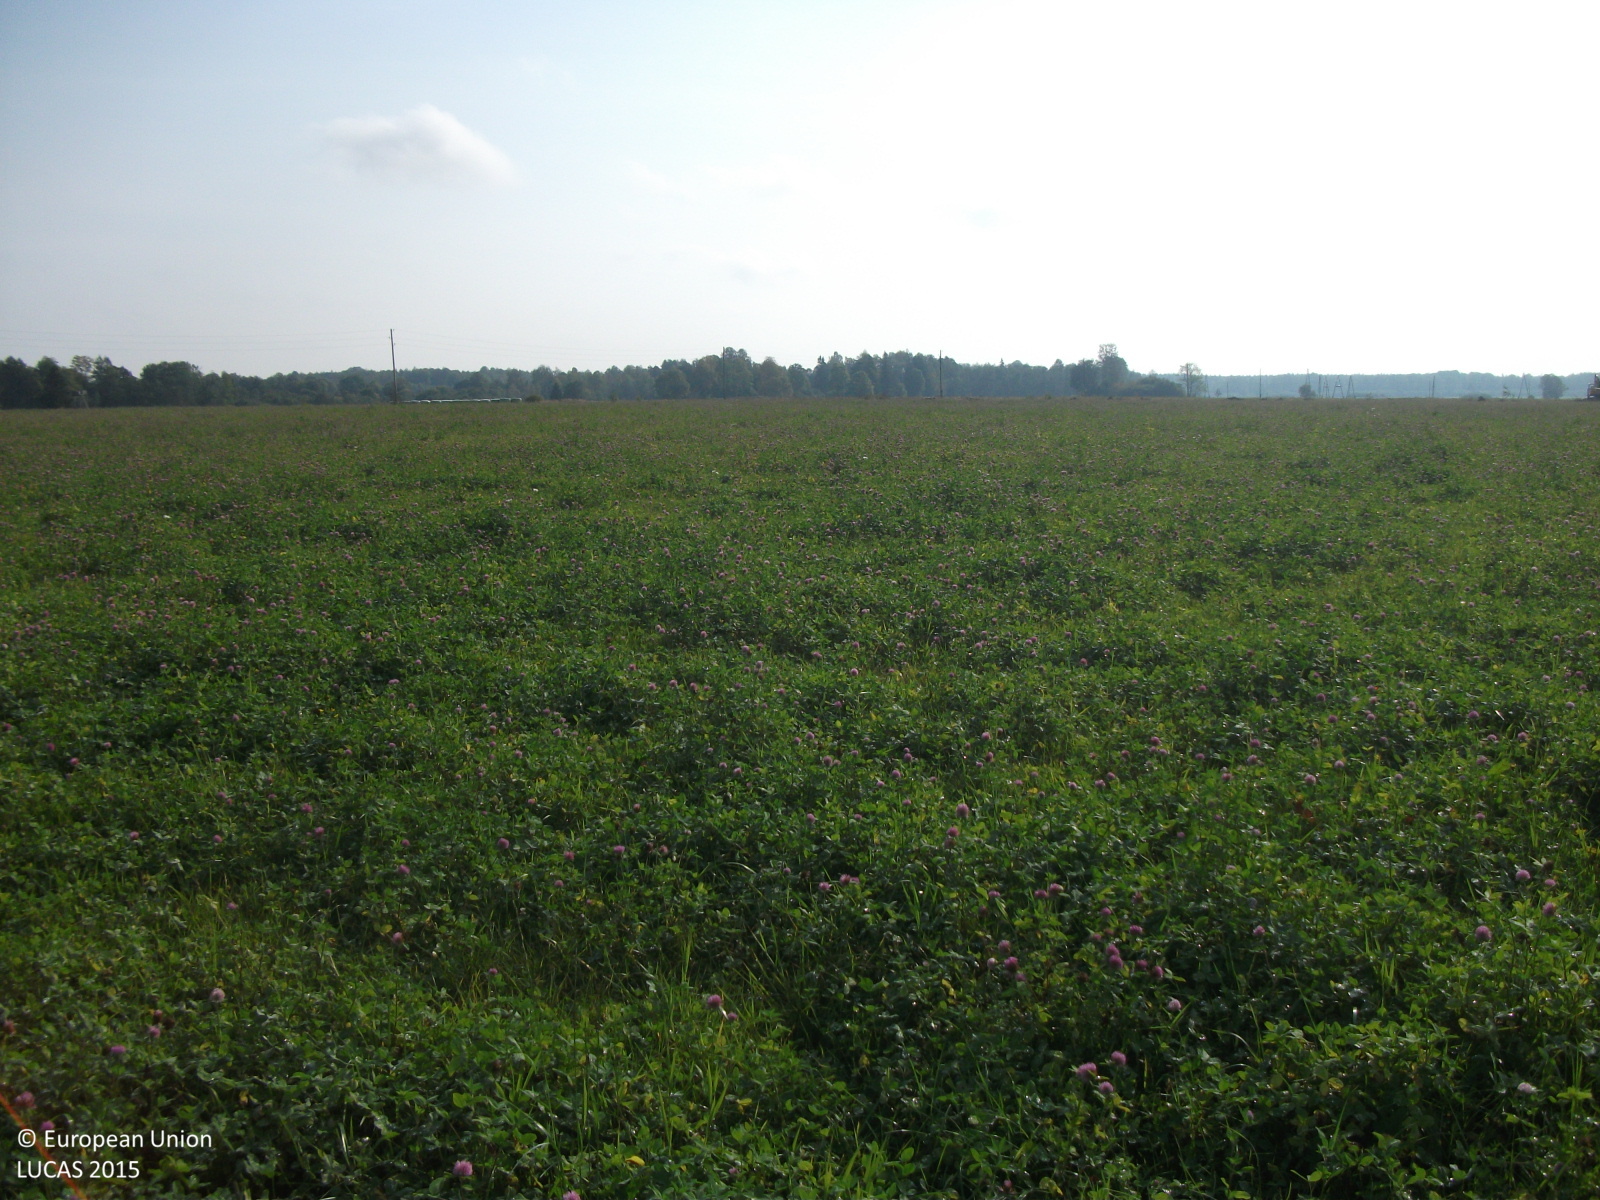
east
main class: Cropland
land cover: Clovers
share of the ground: > 75 %
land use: Agriculture (excluding fallow land and kitchen gardens)
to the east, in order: Clovers; Electric lines; Clovers
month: September
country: LV
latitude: 57.9001
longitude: 24.8603
